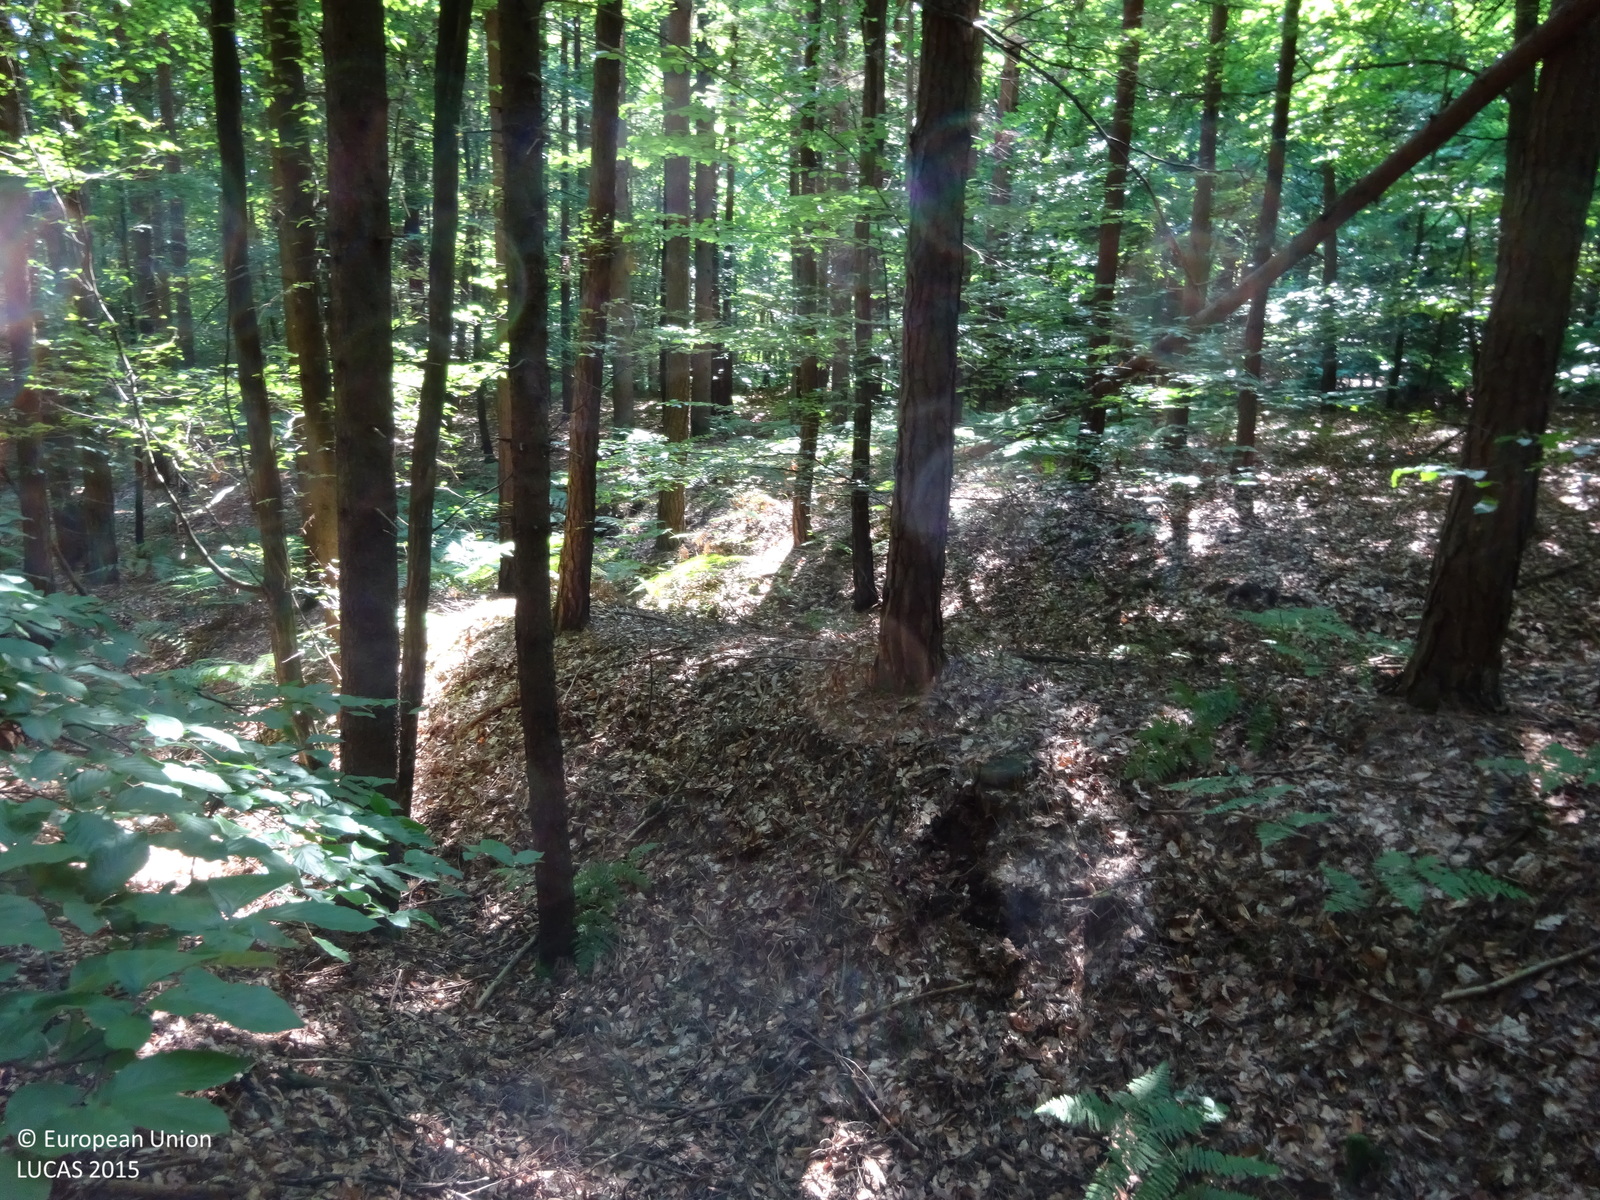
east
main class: Woodland
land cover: Pine dominated mixed woodland
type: hemiboreal forest and nemoral coniferous forest and mixed broadleaved-coniferous forest
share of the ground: > 75 %
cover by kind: broadleaved forest trees 65 %, coniferous forest trees 35 %
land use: Forestry
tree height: > 5 m
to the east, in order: Pine dominated mixed woodland; Ditches and canals; Grass margins; Rivers and streams; Grass margins; Ditches and canals; Pine dominated mixed woodland; Broadleaved woodland; Spruce dominated mixed woodland; Artificial constructions in urban areas
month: July
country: AT
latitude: 46.9171
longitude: 16.1070
